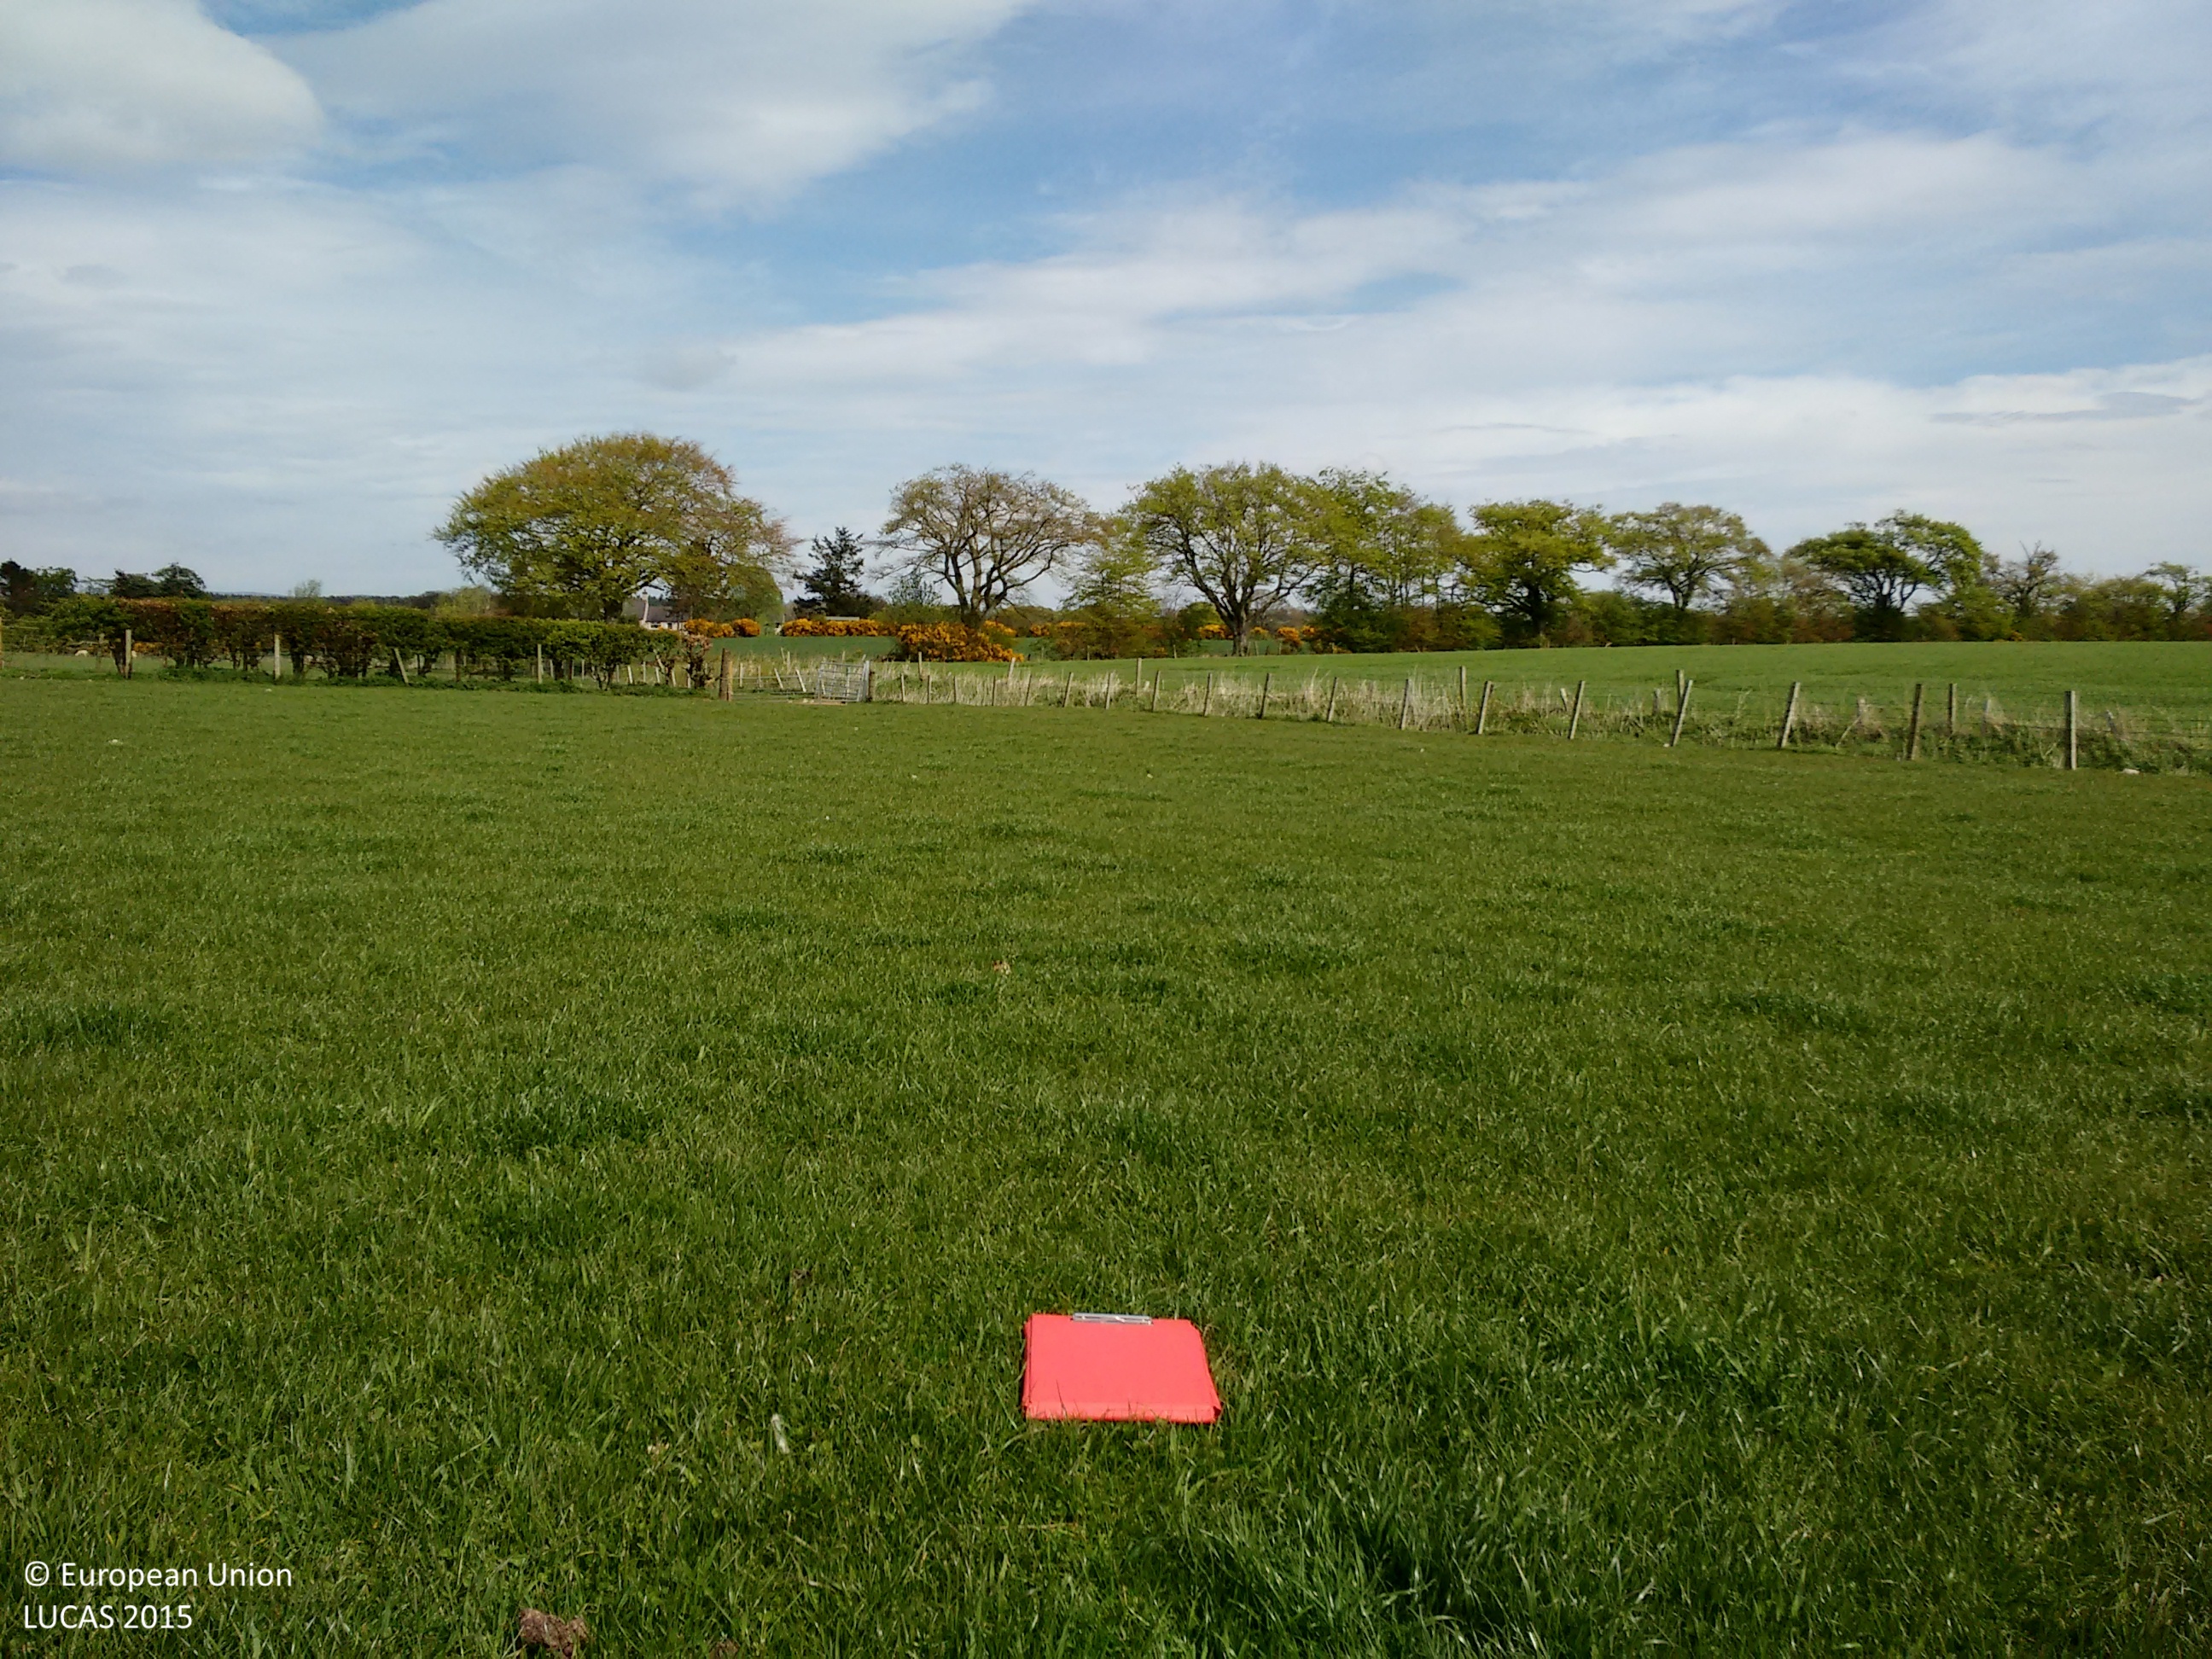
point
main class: Grassland
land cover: Grassland without tree/shrub cover
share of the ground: > 75 %
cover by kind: herbaceous plants 100 %
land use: Agriculture (excluding fallow land and kitchen gardens)
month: May
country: GB
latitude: 56.7451
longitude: -2.6323
